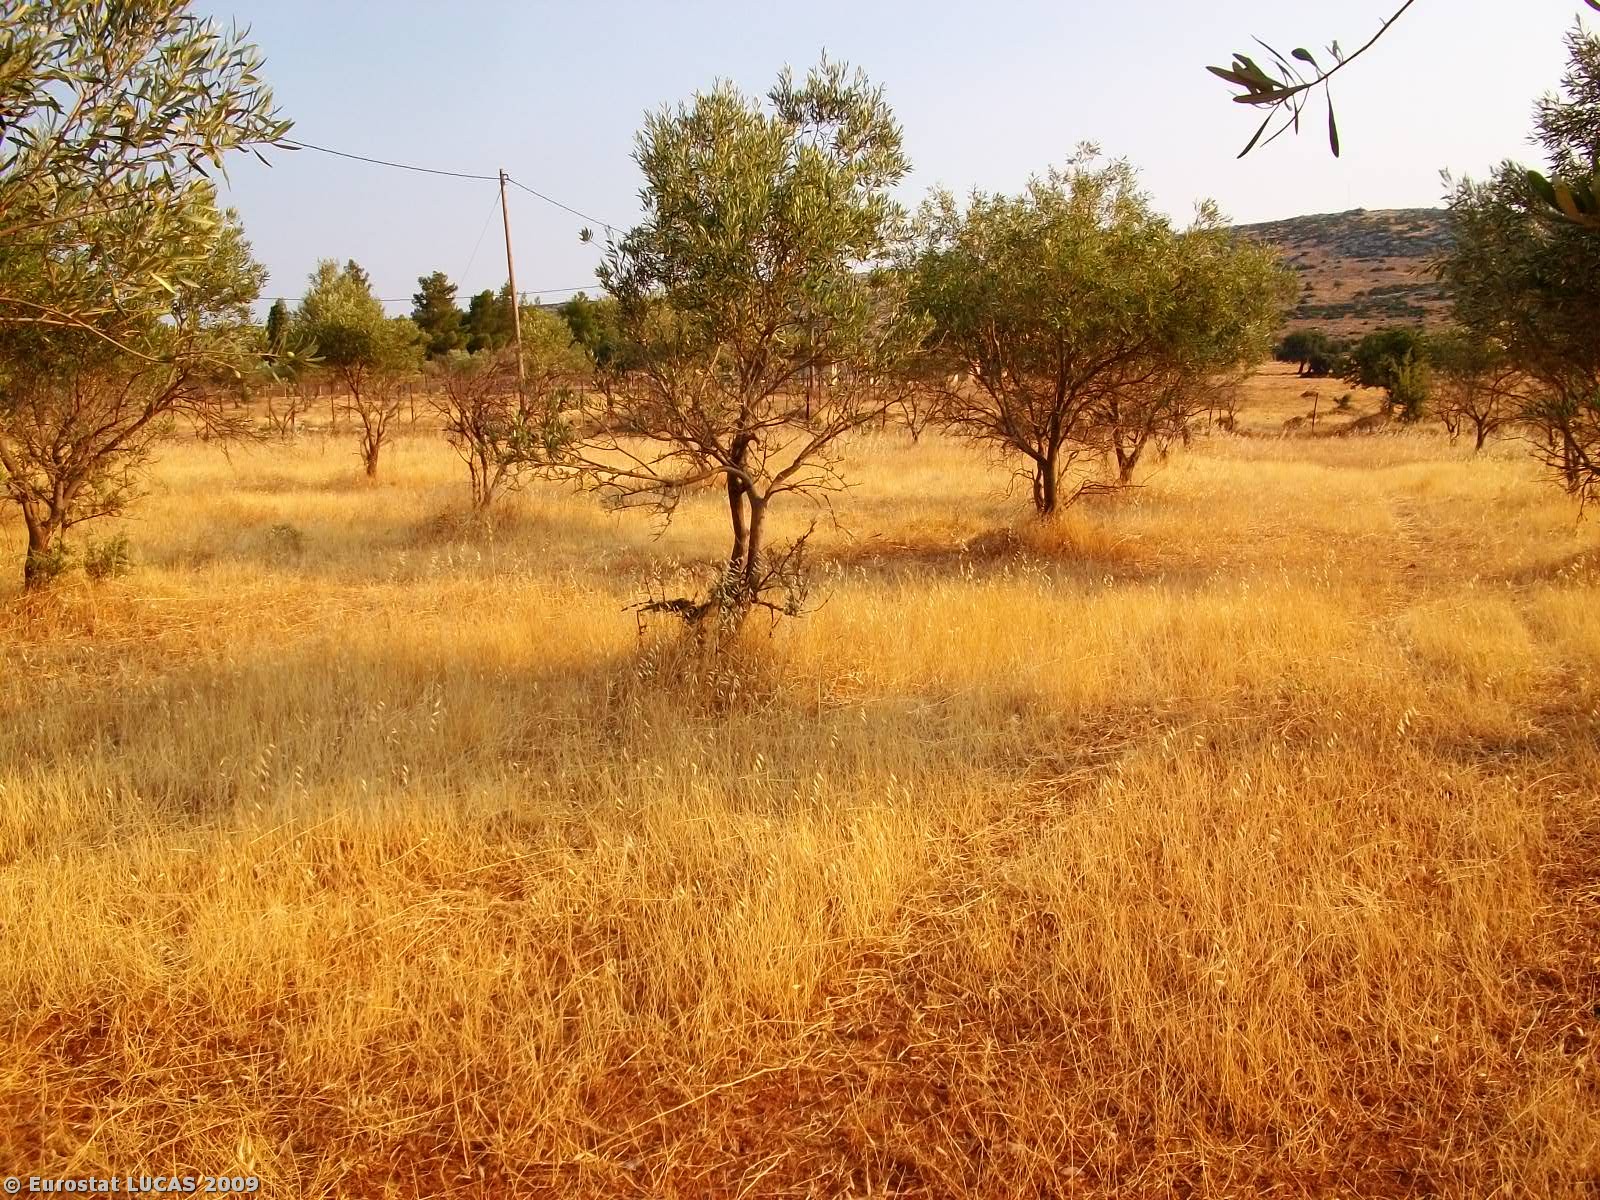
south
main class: Cropland
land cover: Olive groves
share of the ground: 25 - 50 %
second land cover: Grassland with sparse tree/shrub cover
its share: > 75 %
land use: Agriculture (excluding fallow land and kitchen gardens)
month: July
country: GR
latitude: 38.3925
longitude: 22.5811
